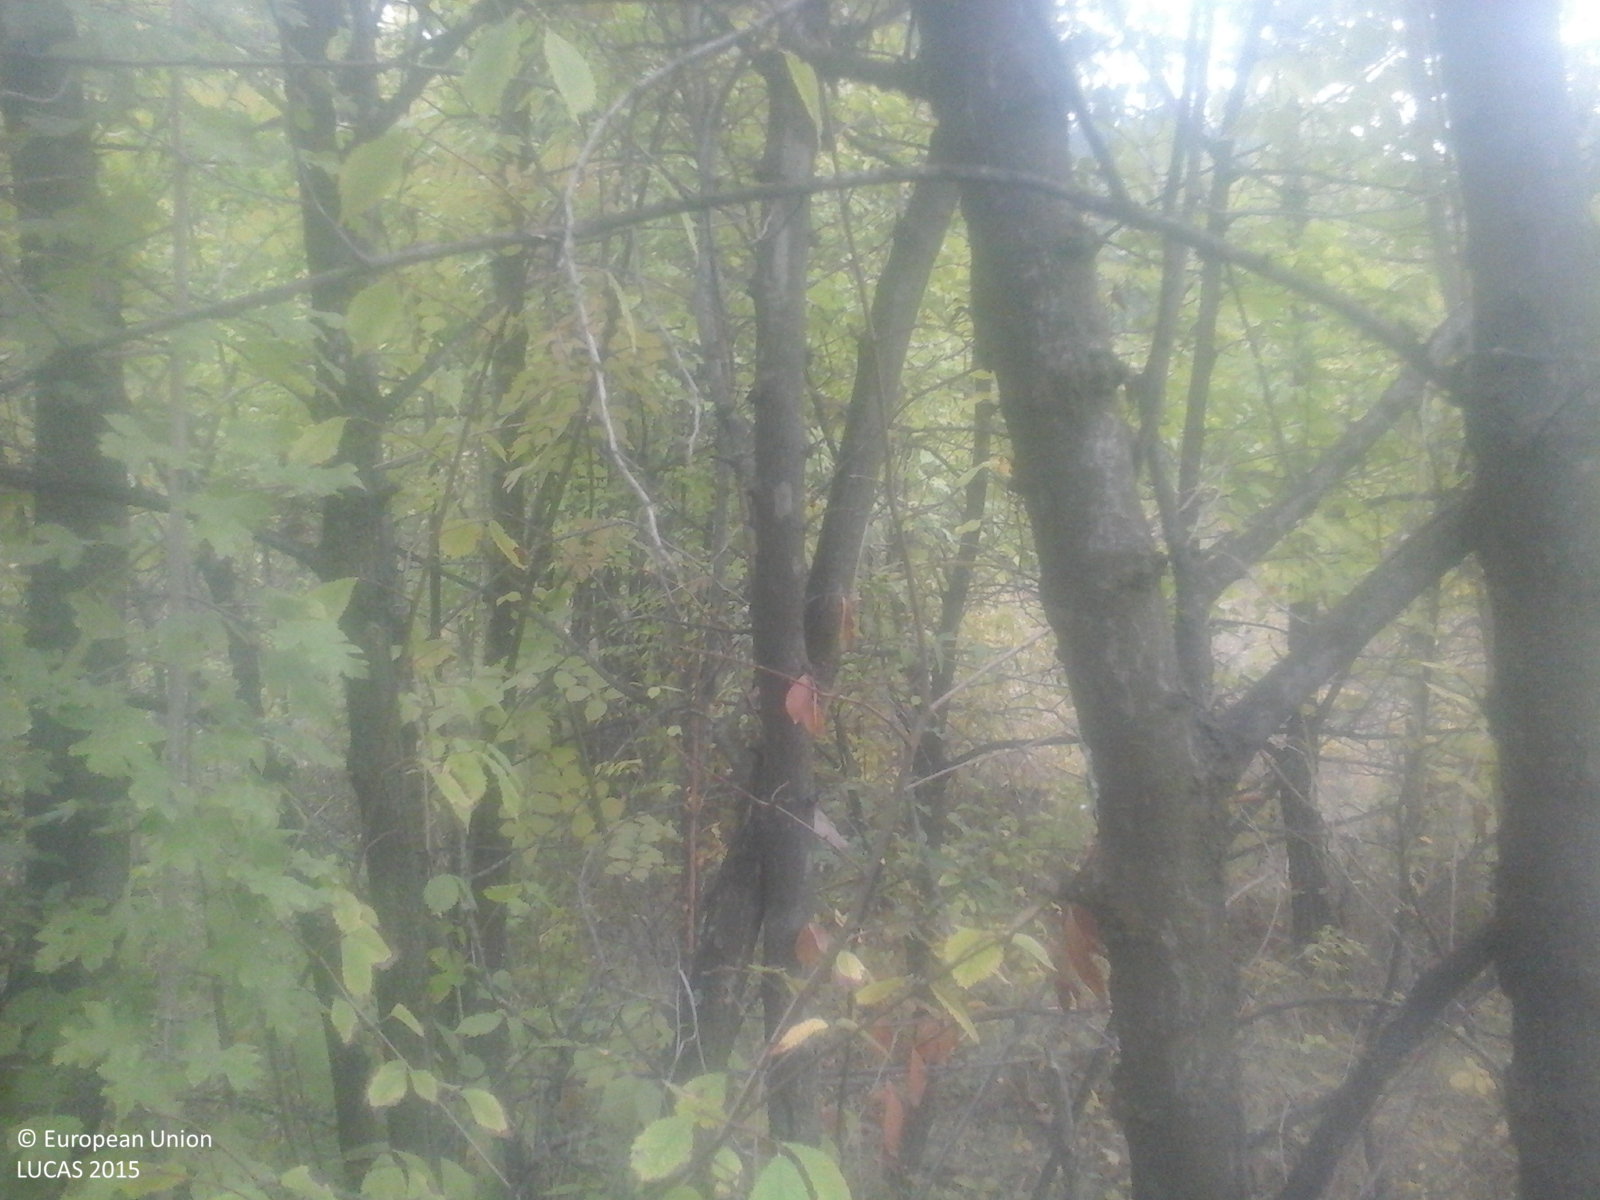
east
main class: Woodland
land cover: Broadleaved woodland
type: beech forest
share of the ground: > 75 %
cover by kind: broadleaved forest trees 100 %
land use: Forestry
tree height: > 5 m
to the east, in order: Broadleaved woodland; Other leguminous and mixtures for fodder; Lines of trees; Shruby margins; Other leguminous and mixtures for fodder; Other fruit trees and berries; Shrubland with sparse tree cover; Broadleaved woodland; Ditches and canals; Grassland with sparse tree/shrub cover; Broadleaved woodland
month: September
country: RO
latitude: 44.8041
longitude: 23.1609
